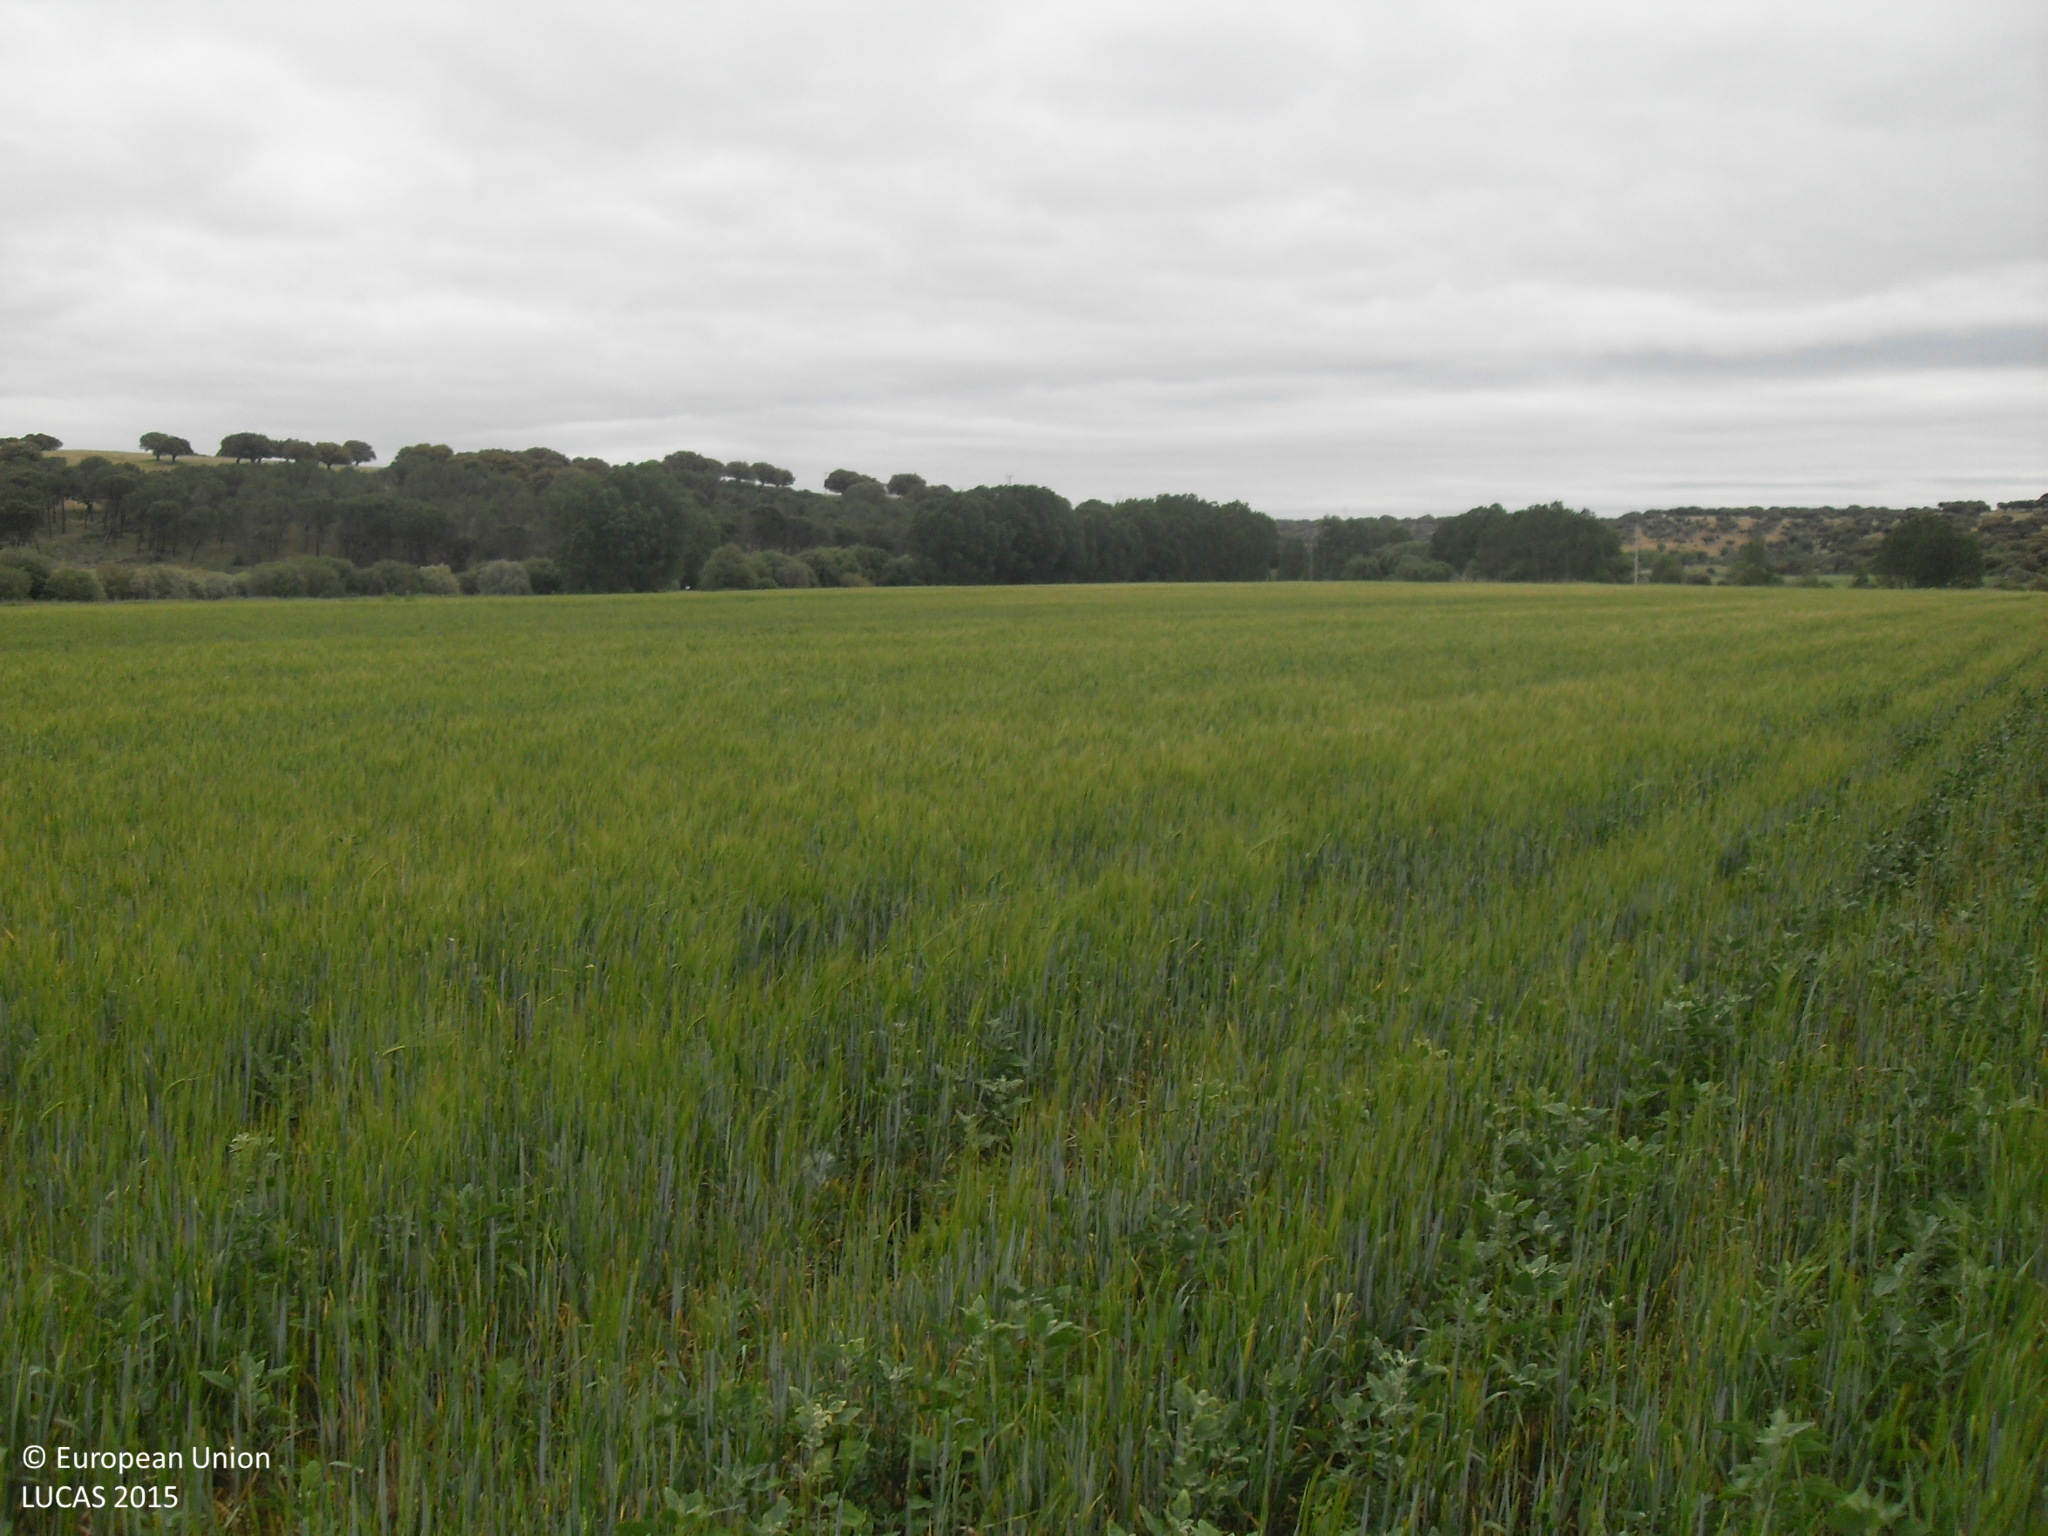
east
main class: Cropland
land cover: Barley
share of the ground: > 75 %
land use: Agriculture (excluding fallow land and kitchen gardens)
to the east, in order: Barley
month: May
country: ES
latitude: 40.6750
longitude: -5.6537
